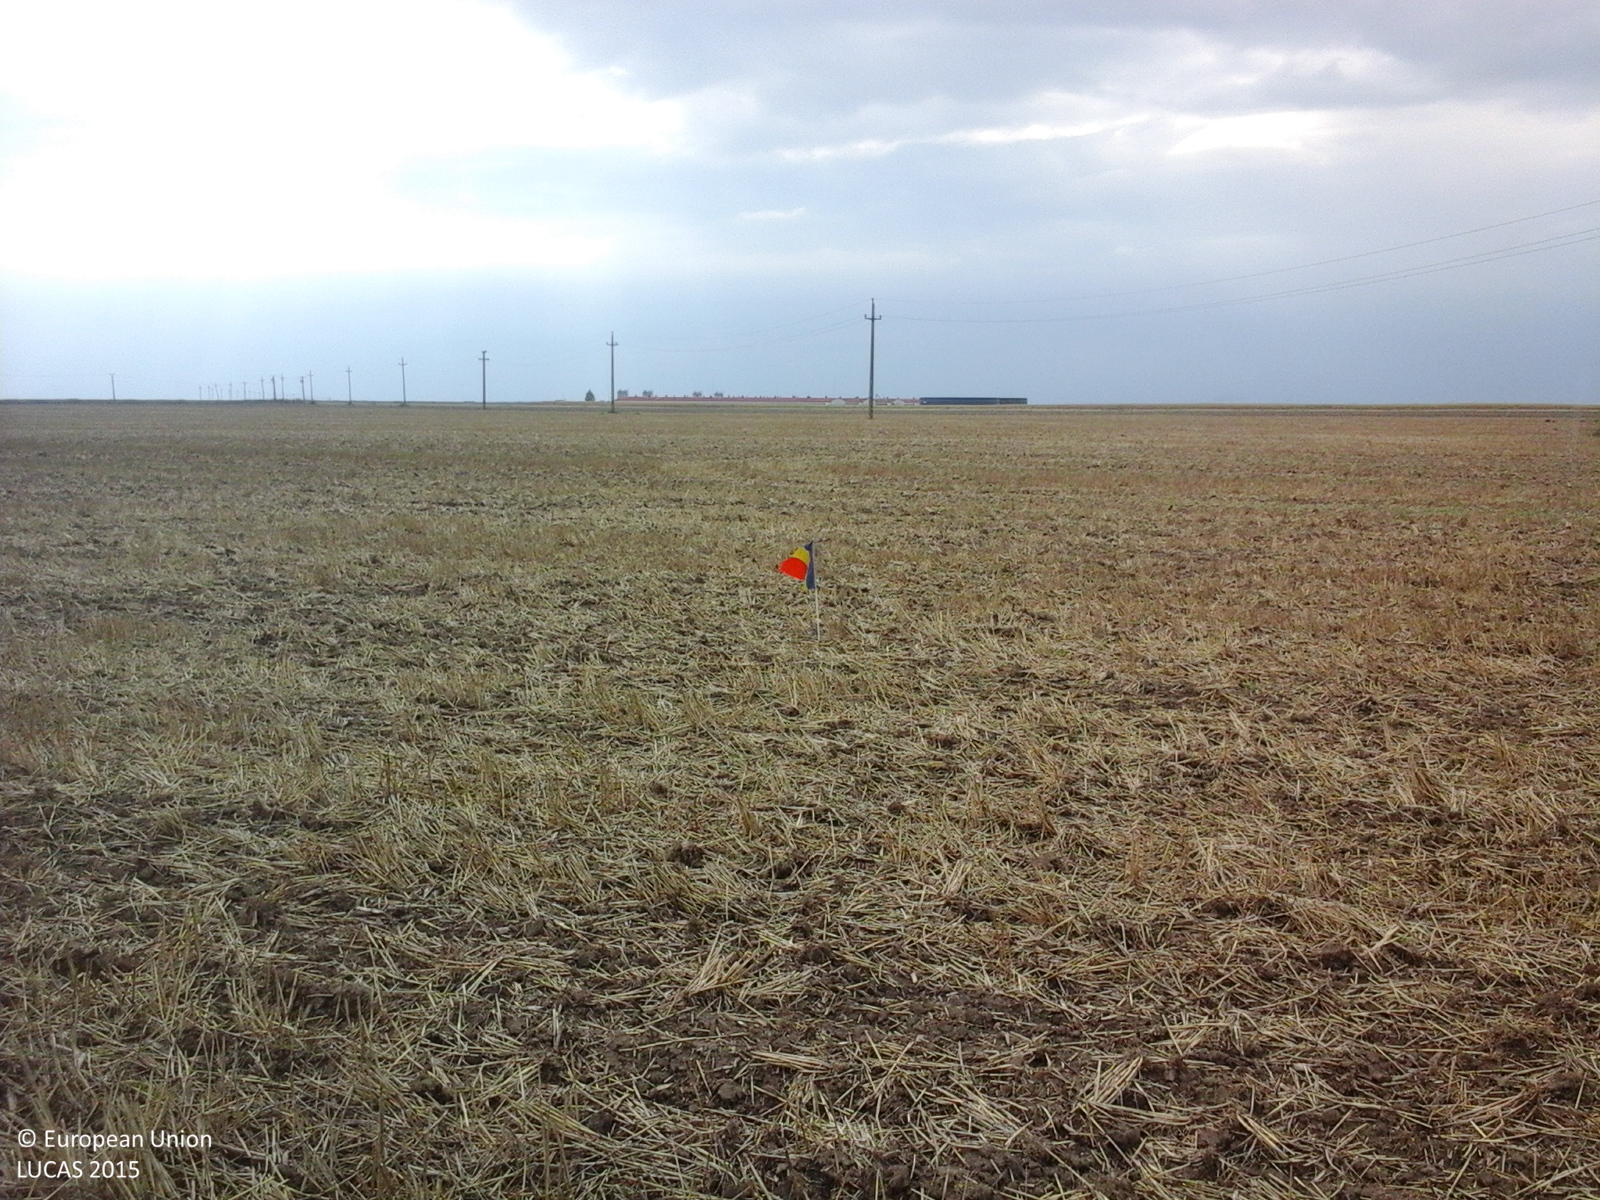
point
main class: Cropland
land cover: Common wheat
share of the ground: 50 - 75 %
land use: Agriculture (excluding fallow land and kitchen gardens)
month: August
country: RO
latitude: 46.0070
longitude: 20.5757
